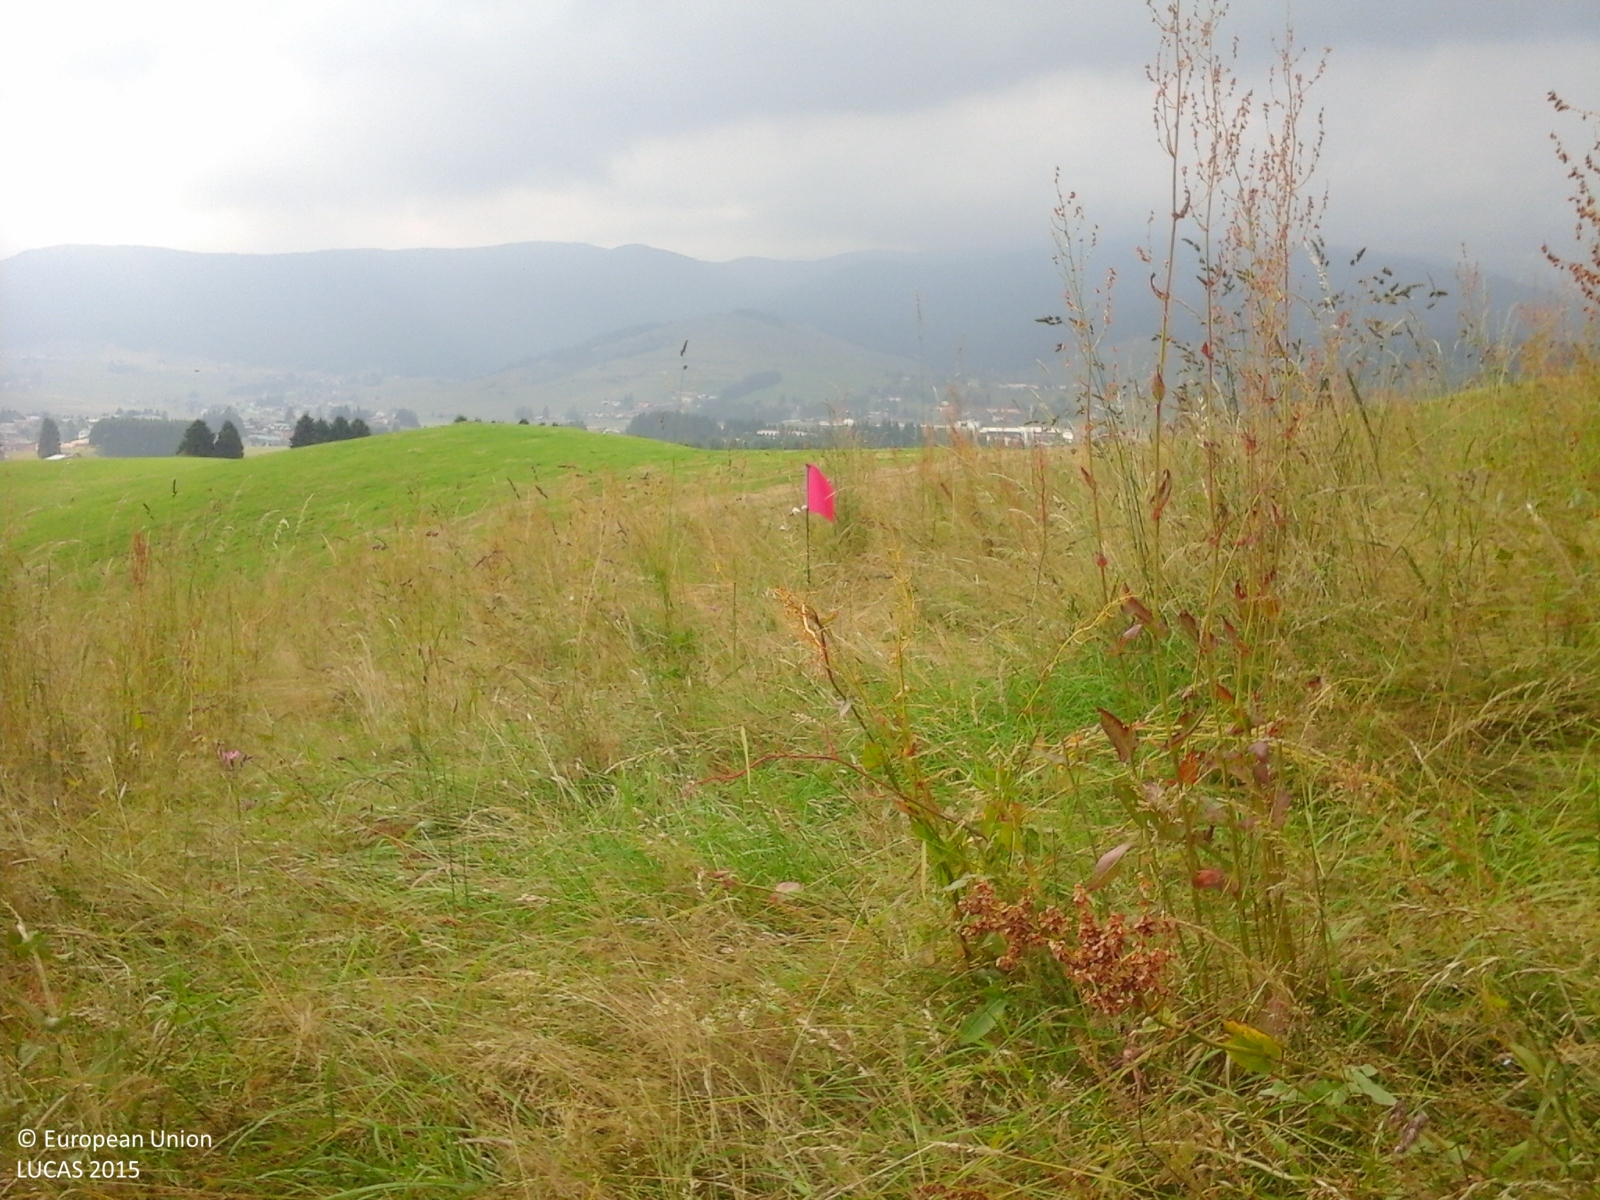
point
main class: Grassland
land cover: Grassland without tree/shrub cover
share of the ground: > 75 %
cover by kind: herbaceous plants 100 %
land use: Agriculture (excluding fallow land and kitchen gardens)
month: June
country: IT
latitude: 45.8718
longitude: 11.5308
